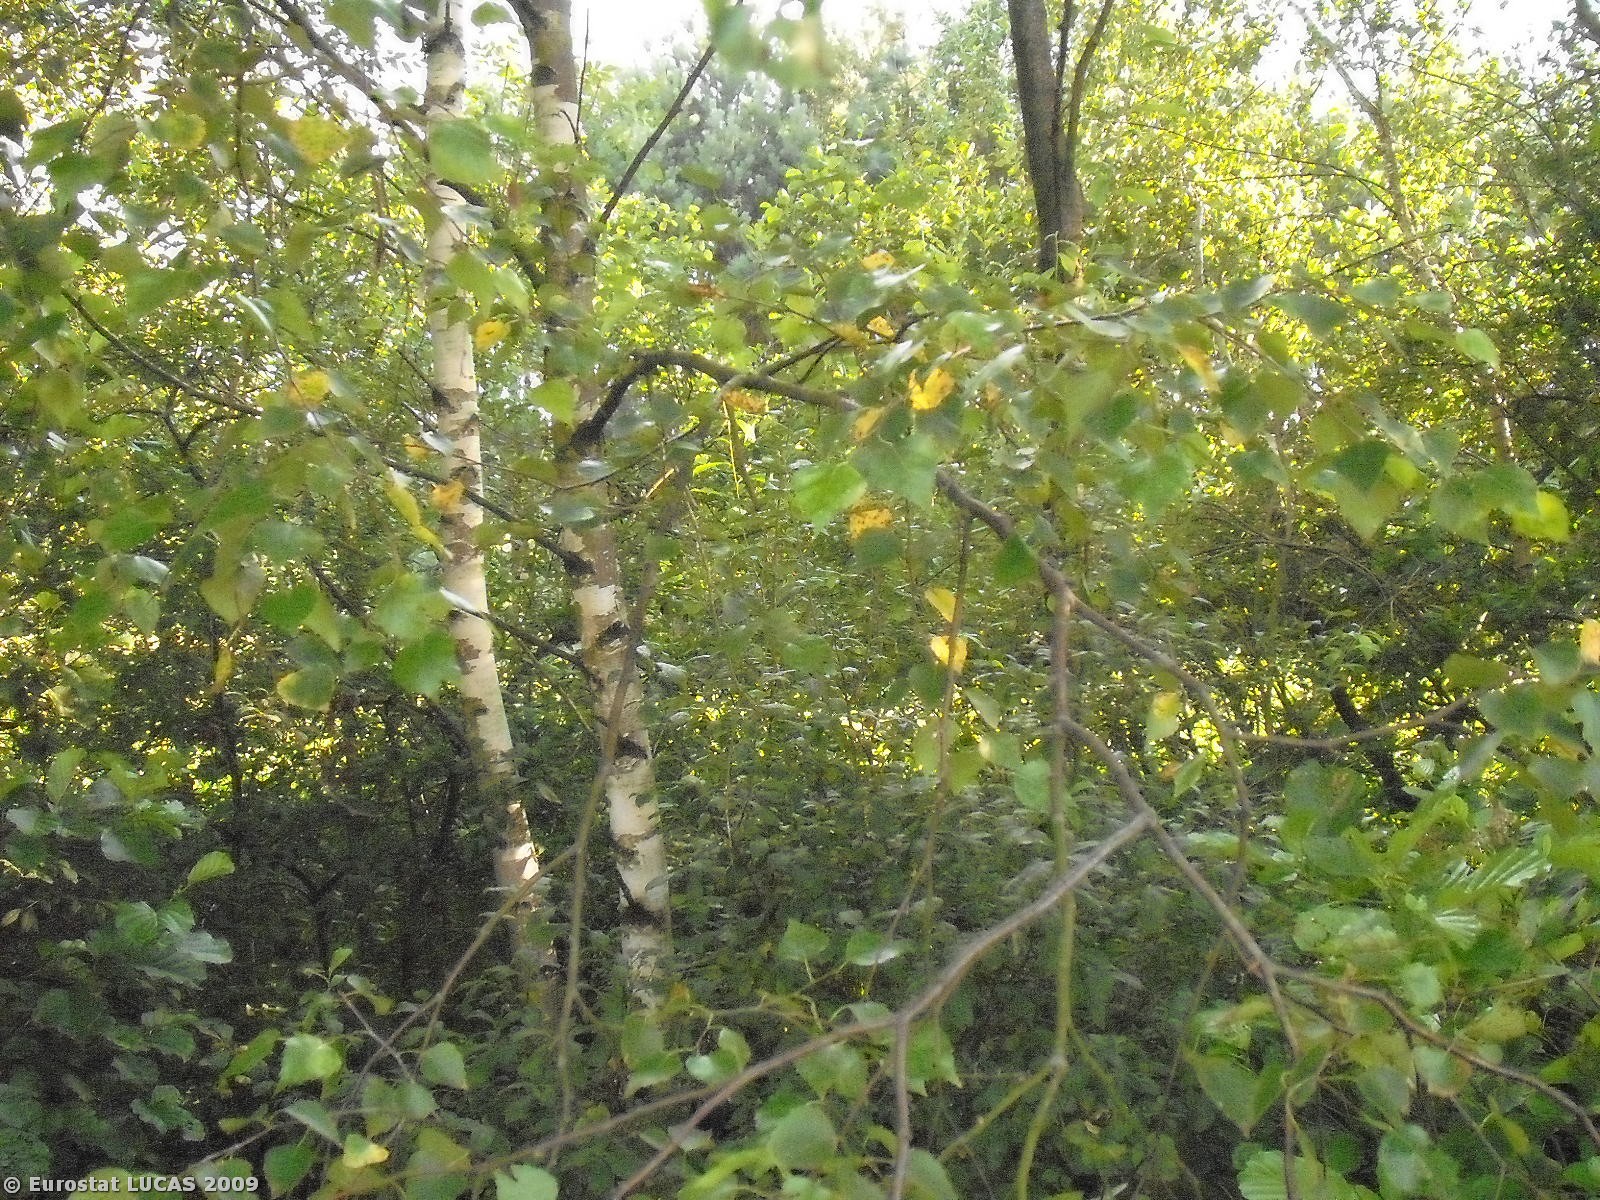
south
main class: Woodland
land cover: Broadleaved woodland
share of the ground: > 75 %
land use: Unused
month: August
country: PL
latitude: 50.5293
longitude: 21.2912
